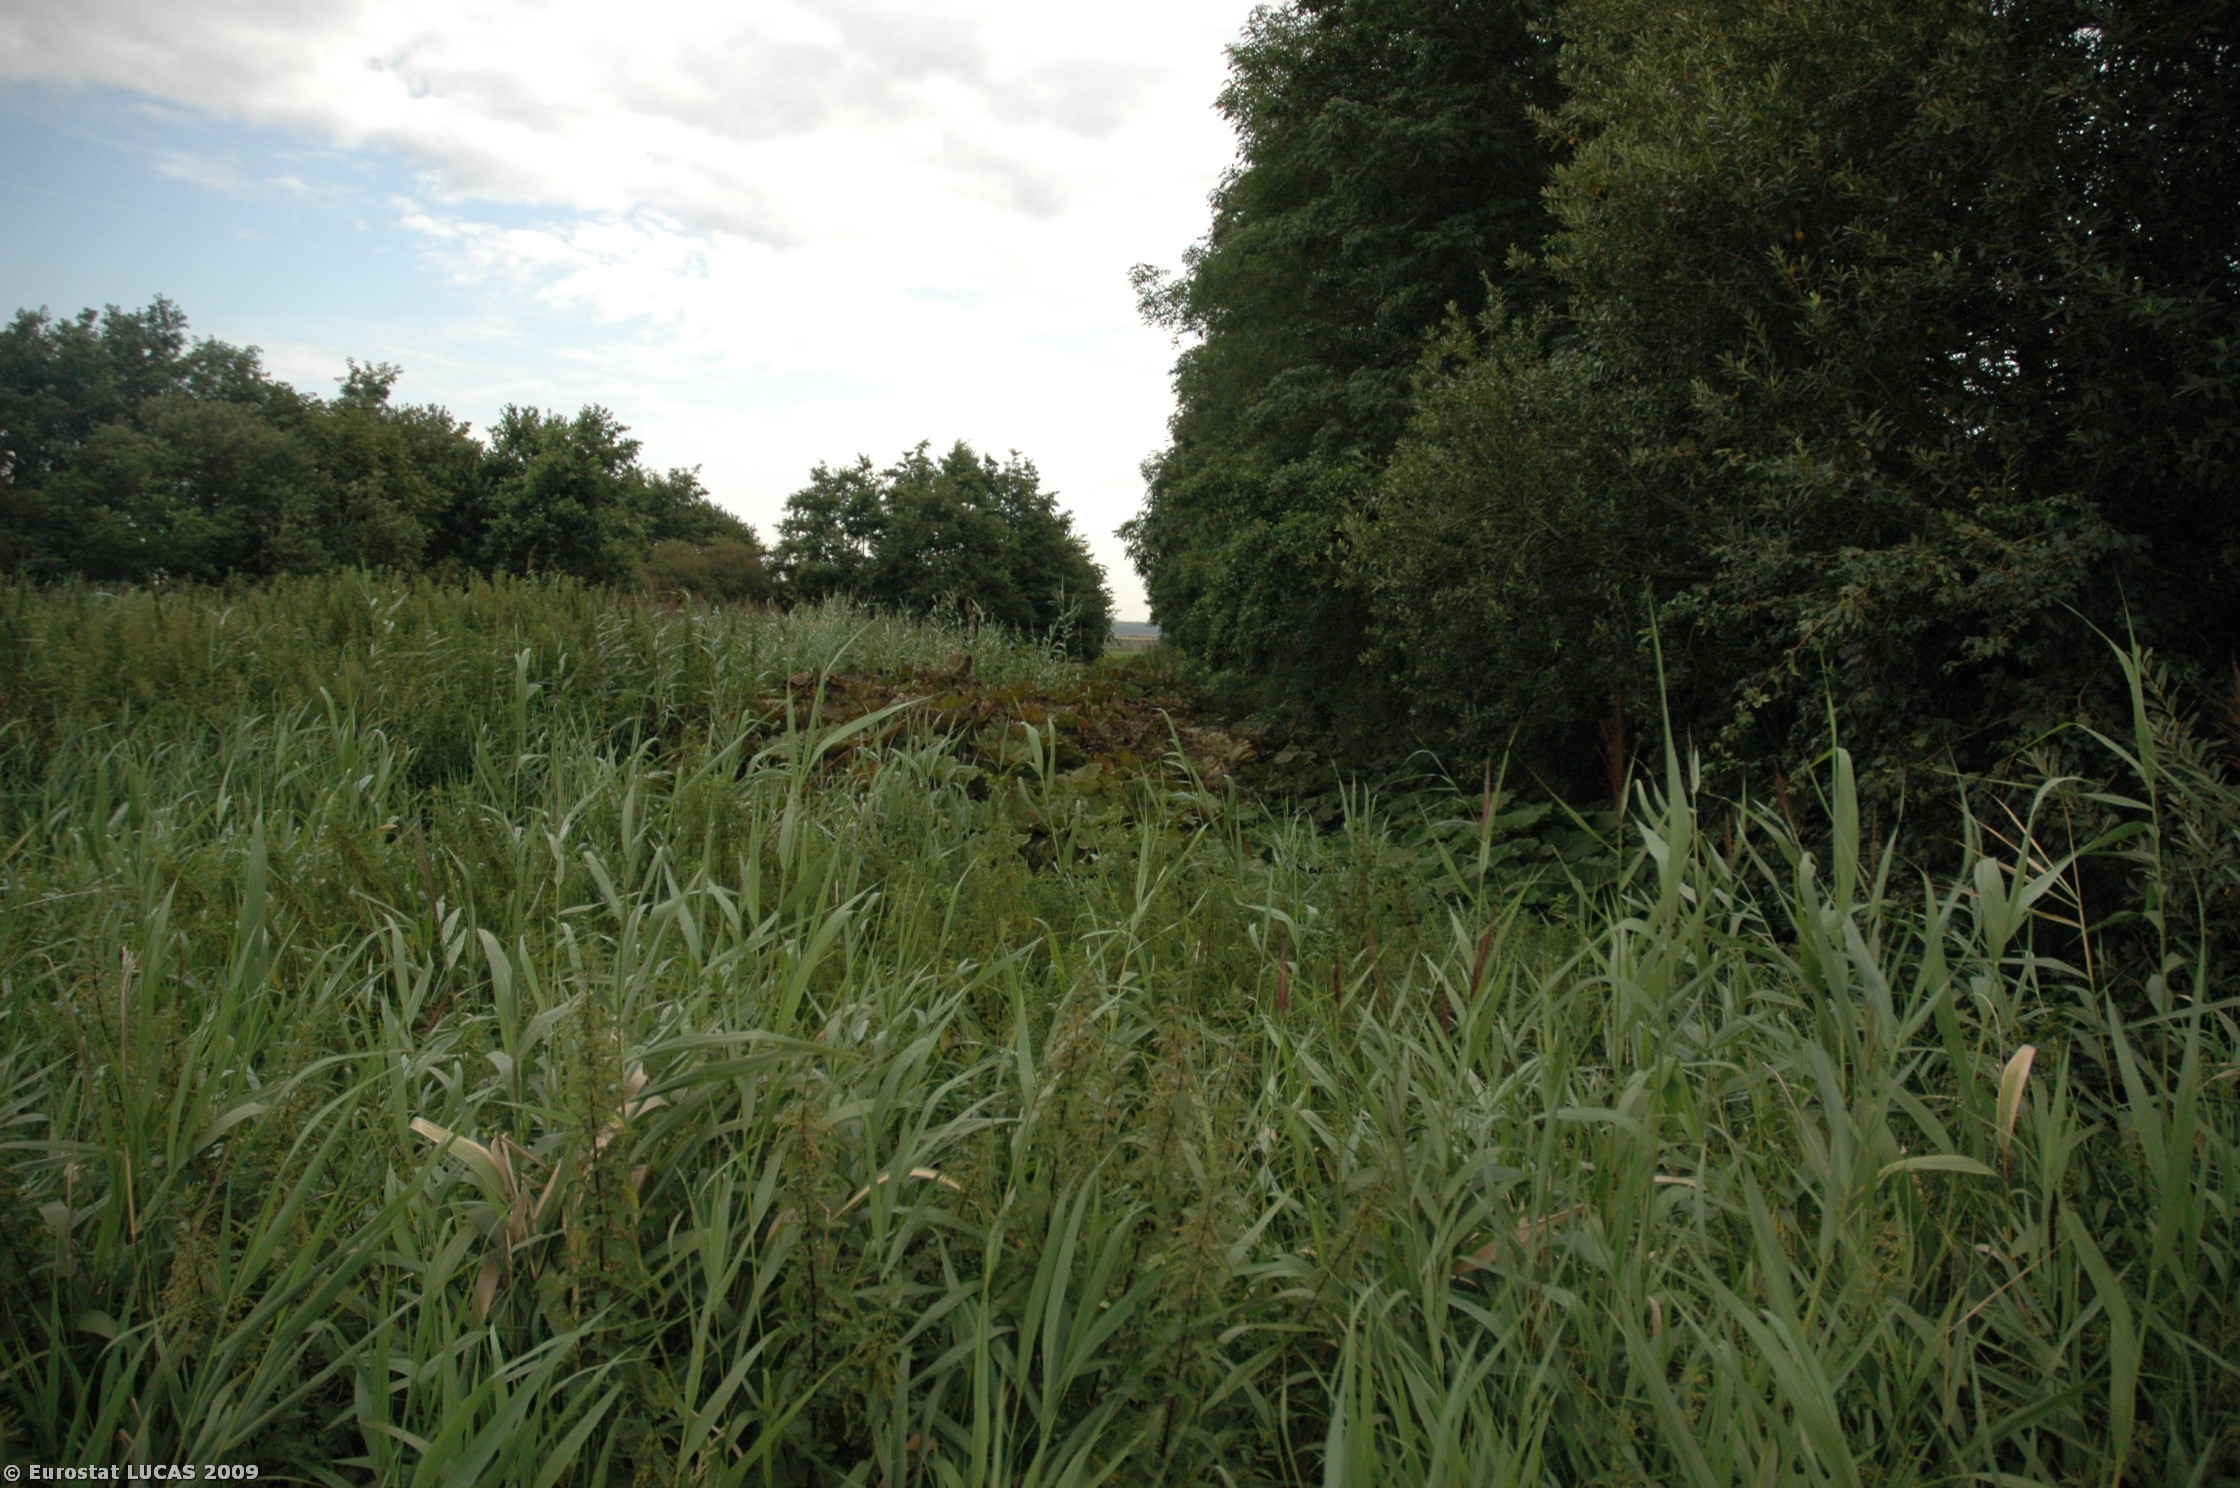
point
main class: Grassland
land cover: Grassland without tree/shrub cover
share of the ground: > 75 %
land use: Agriculture (excluding fallow land and kitchen gardens)
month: August
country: NL
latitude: 52.3055
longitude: 5.3783
